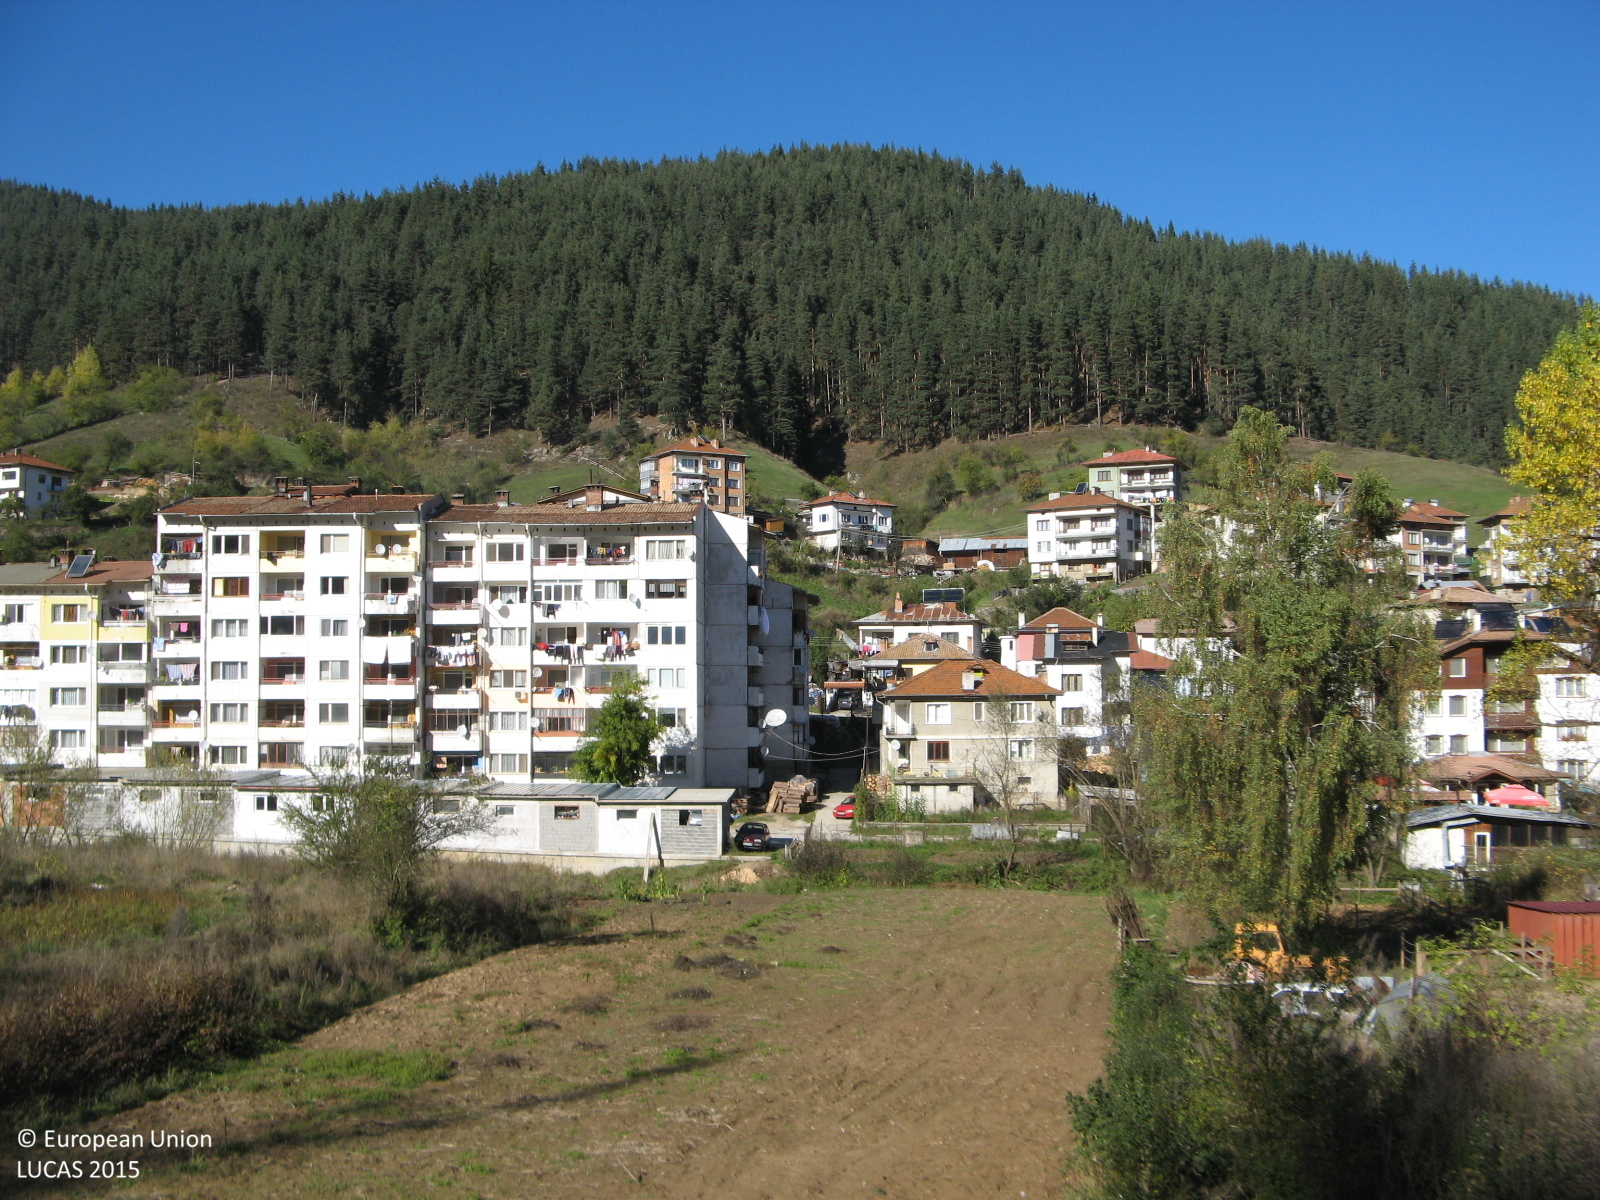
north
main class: Cropland
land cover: Potatoes
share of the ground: < 10 %
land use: Agriculture (excluding fallow land and kitchen gardens)
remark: Harvested field
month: October
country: BG
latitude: 41.7251
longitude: 24.6749
